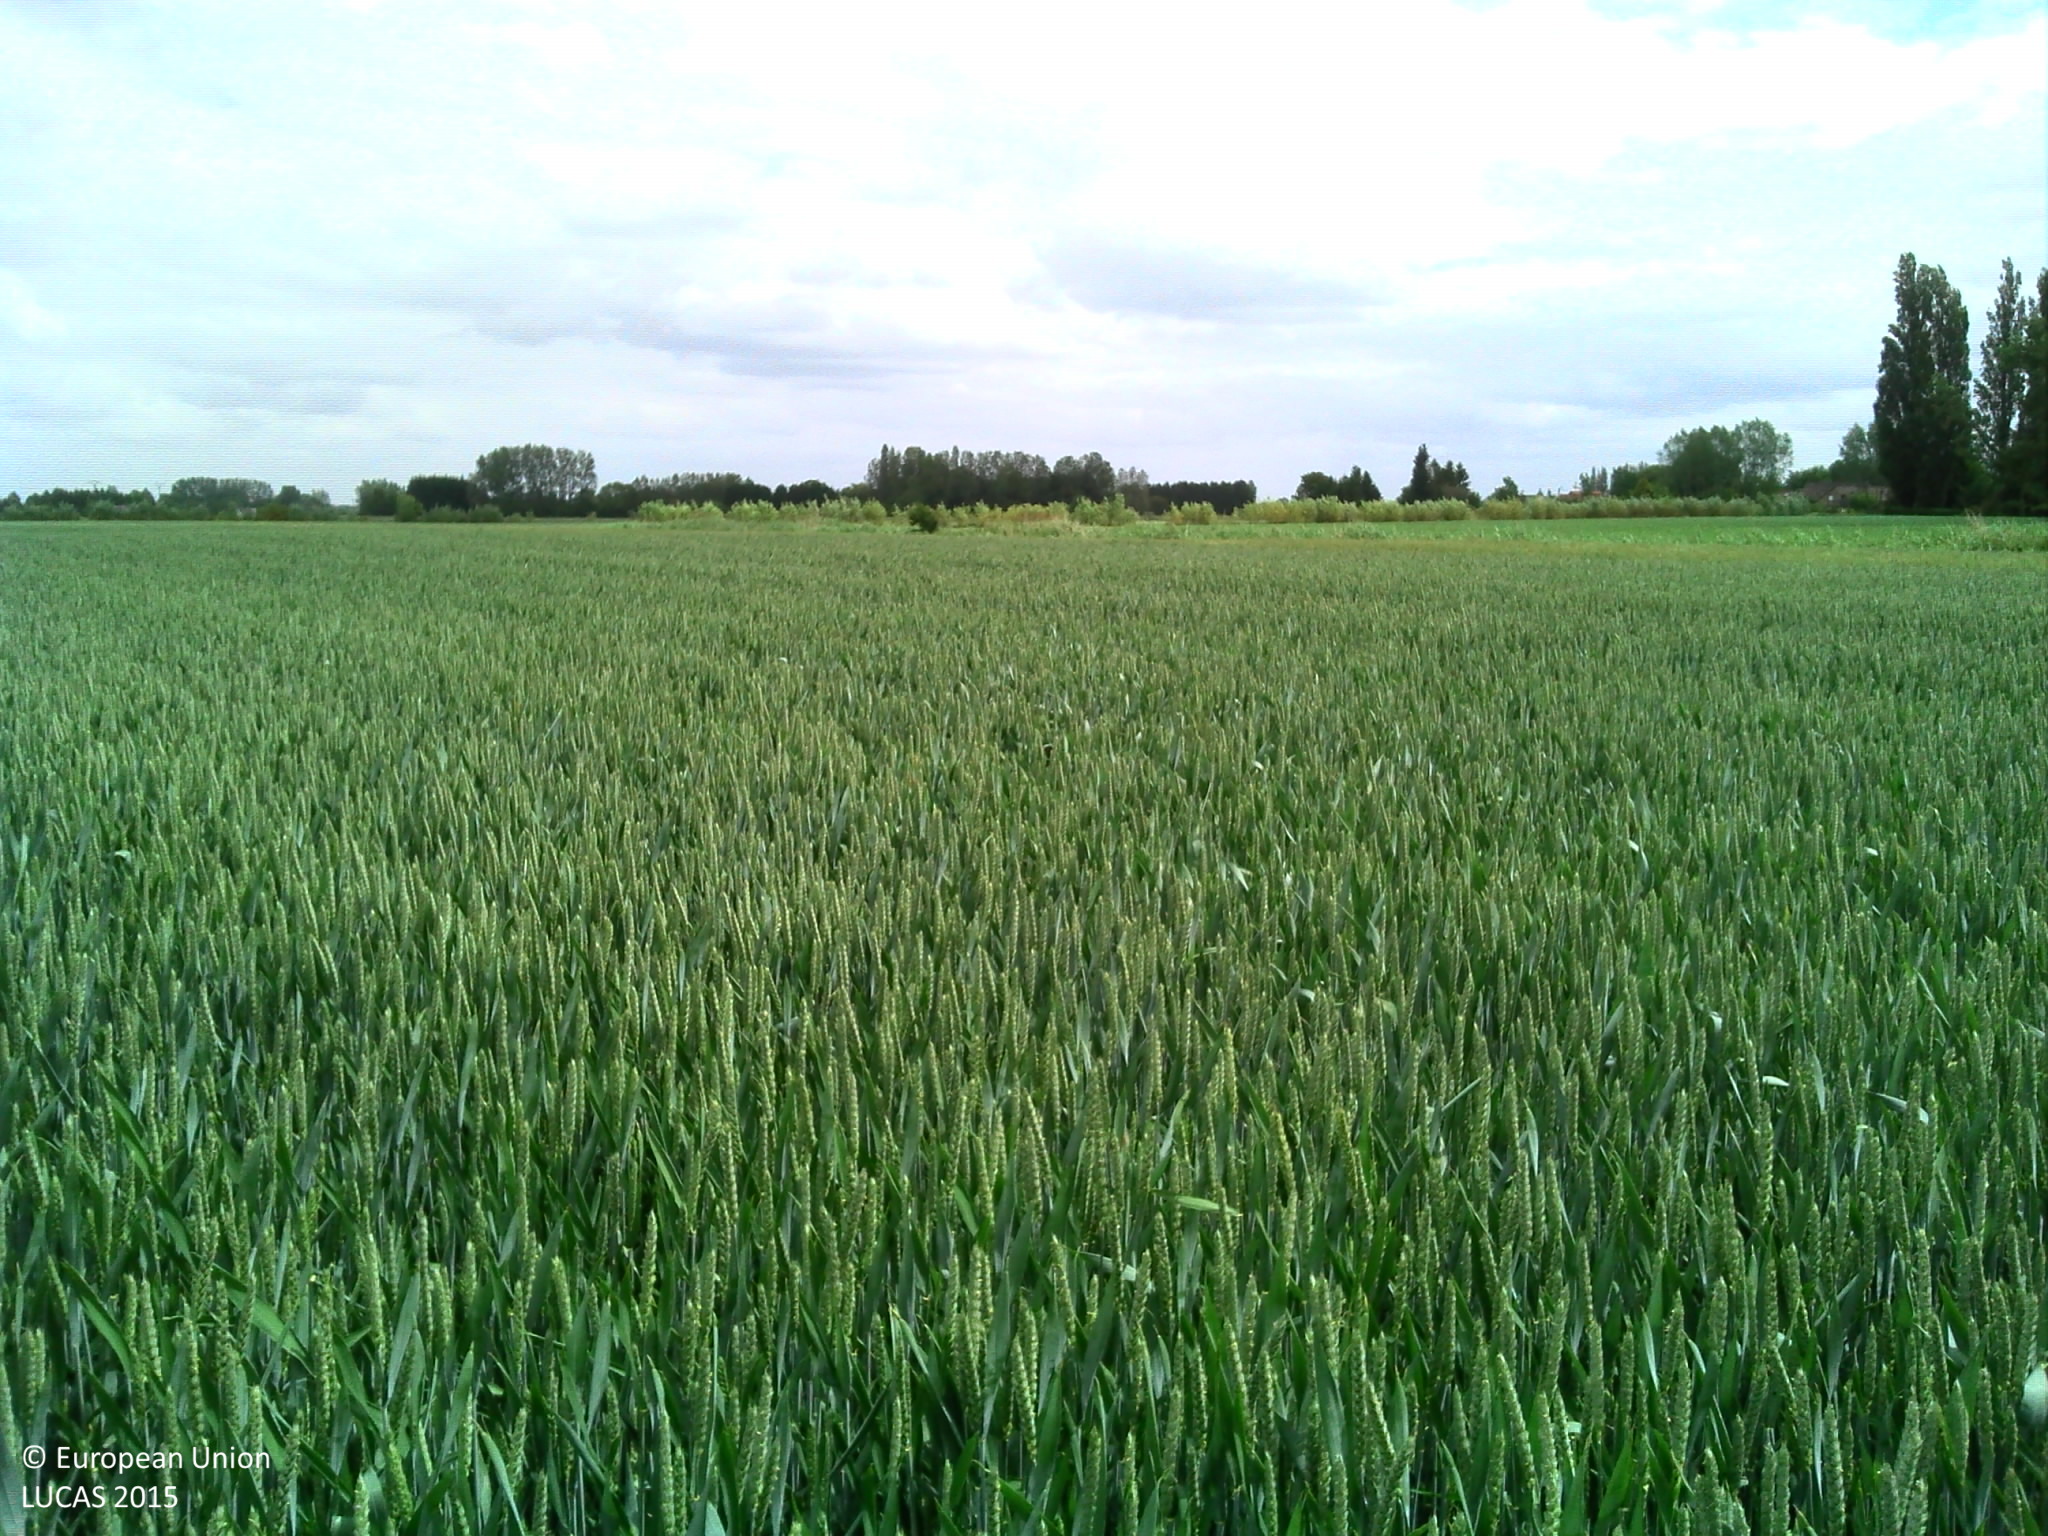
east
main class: Cropland
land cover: Common wheat
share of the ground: > 75 %
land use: Agriculture (excluding fallow land and kitchen gardens)
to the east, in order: Common wheat; Ditches and canals; Common wheat; Managed hedges; Common wheat
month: June
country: FR
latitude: 50.6027
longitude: 2.7404
